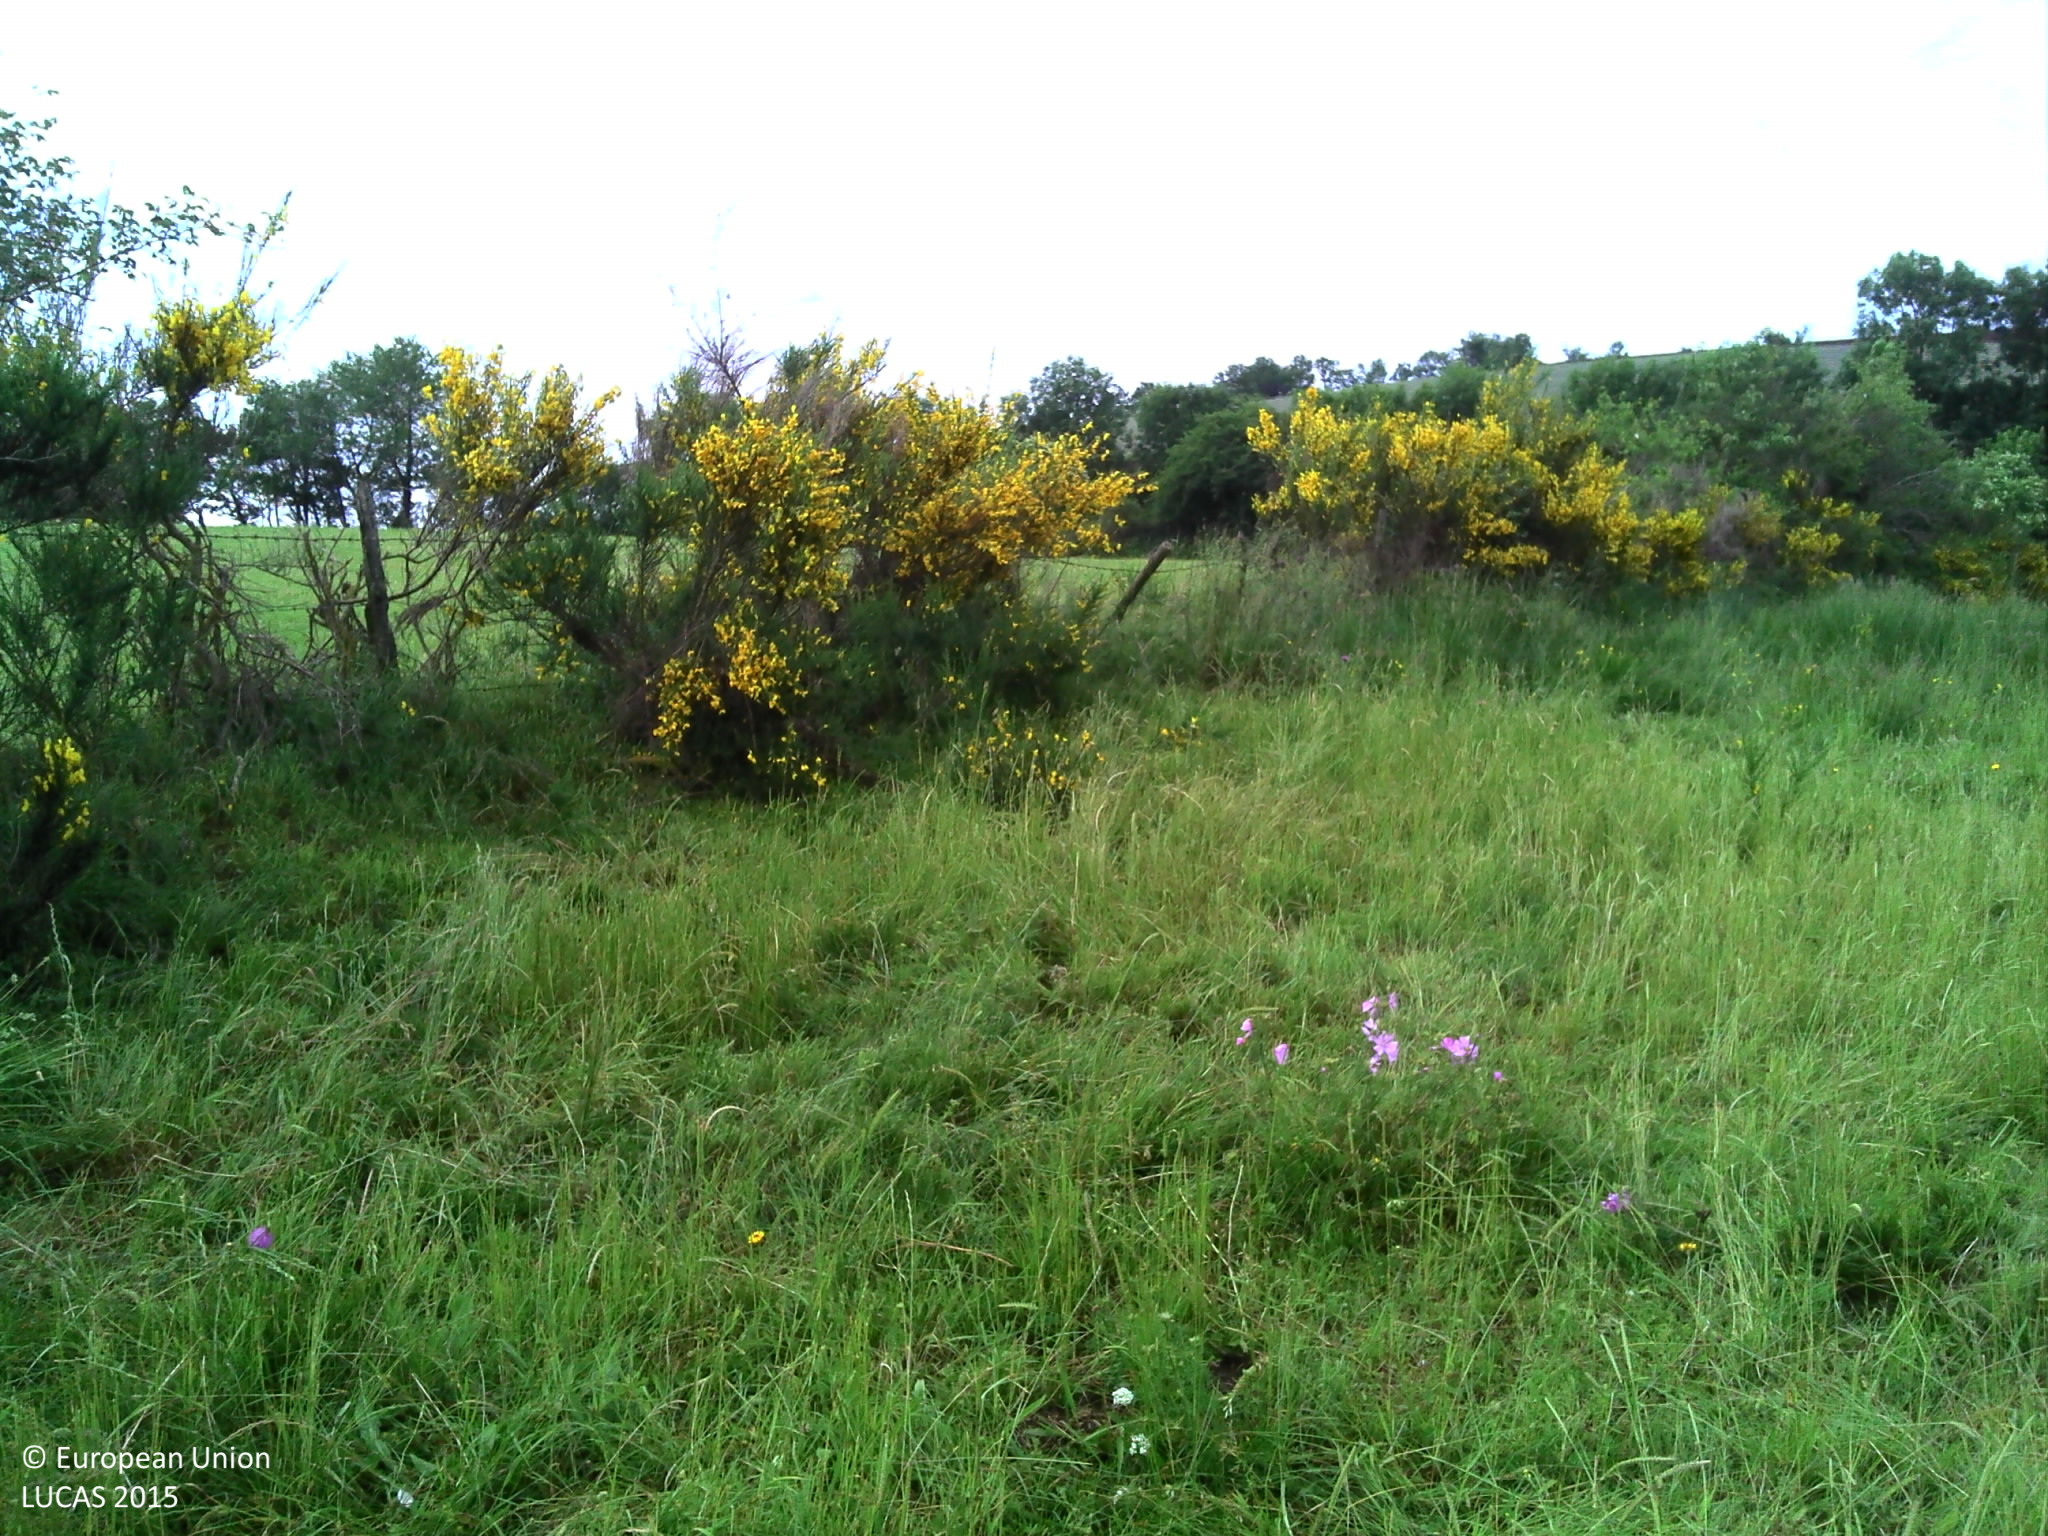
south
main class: Grassland
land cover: Grassland without tree/shrub cover
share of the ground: > 75 %
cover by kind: herbaceous plants 95 %, shrubs 5 %
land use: Agriculture (excluding fallow land and kitchen gardens)
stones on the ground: 10 - 25 %
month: June
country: FR
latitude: 44.2574
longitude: 2.9784
